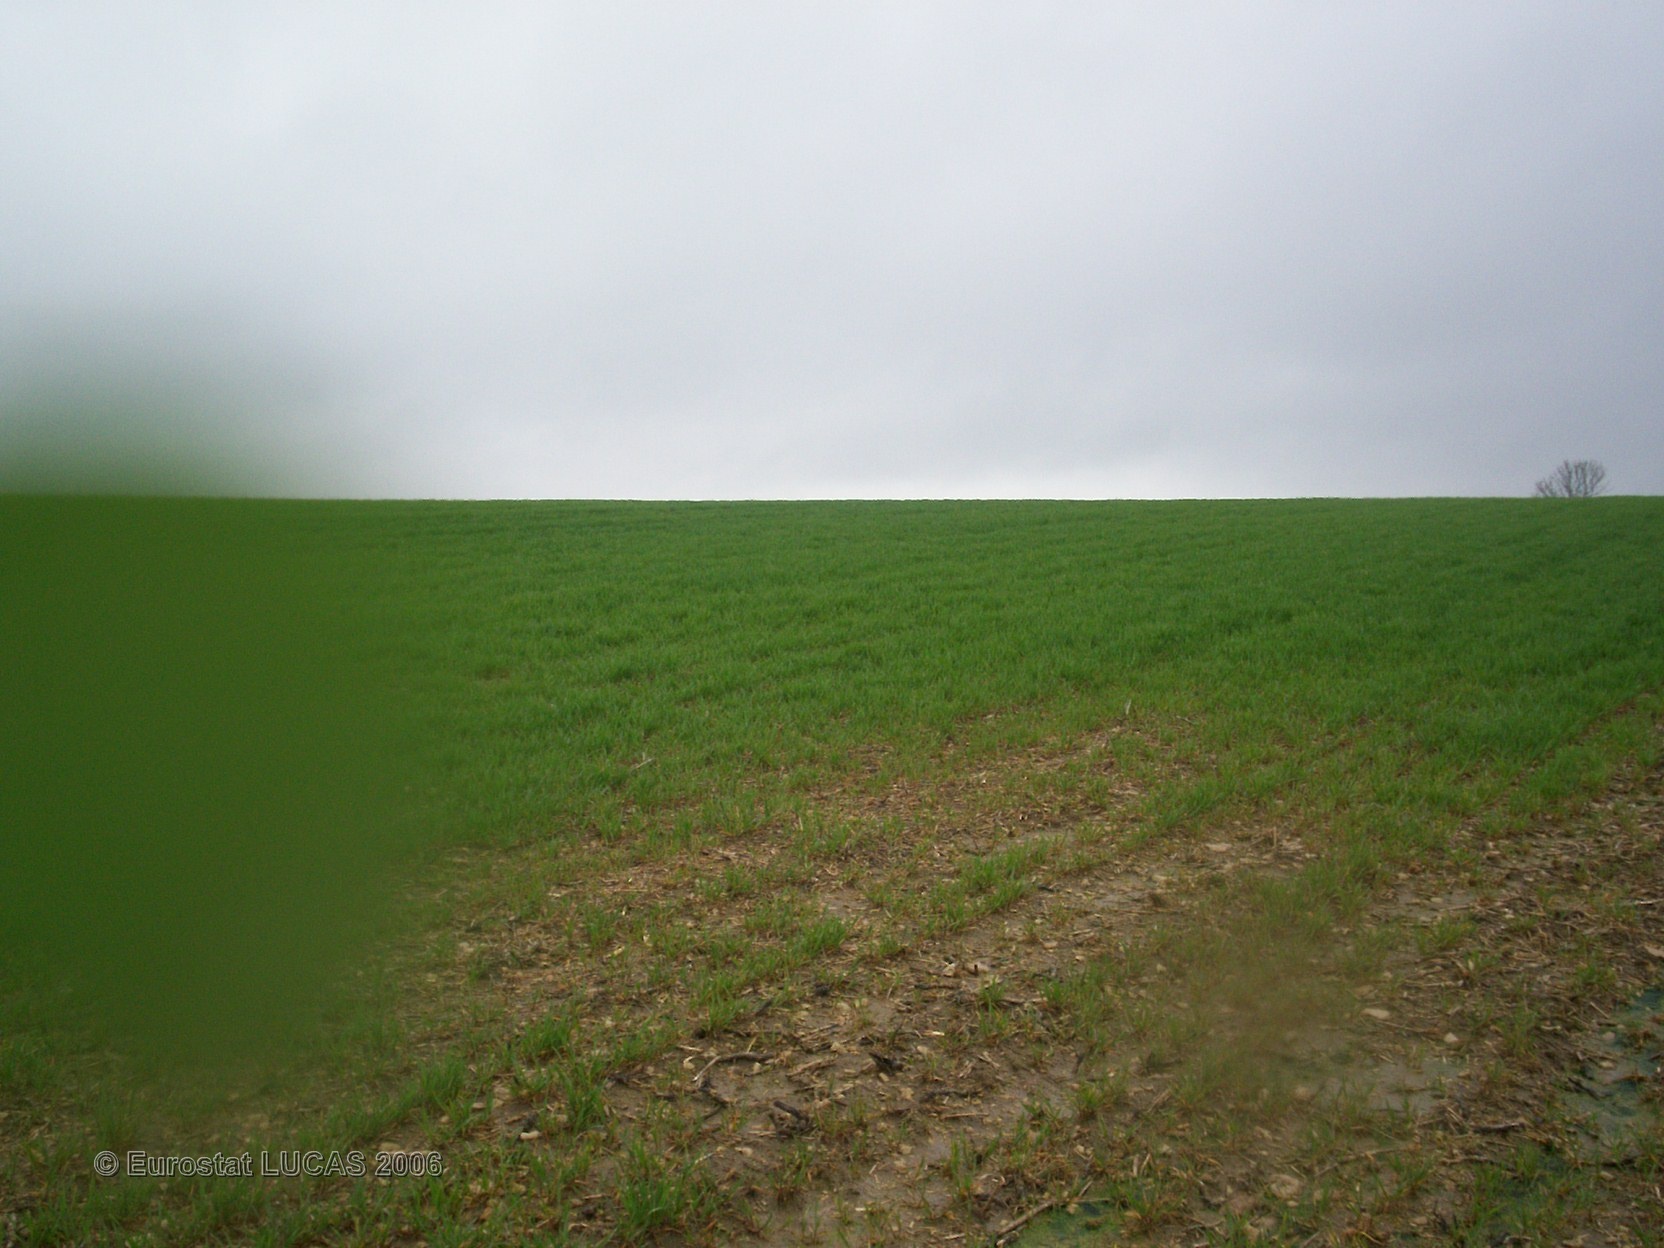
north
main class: Cropland
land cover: Barley
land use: Agriculture (excluding fallow land and kitchen gardens)
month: April
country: FR
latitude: 48.0932
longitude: 4.6410
